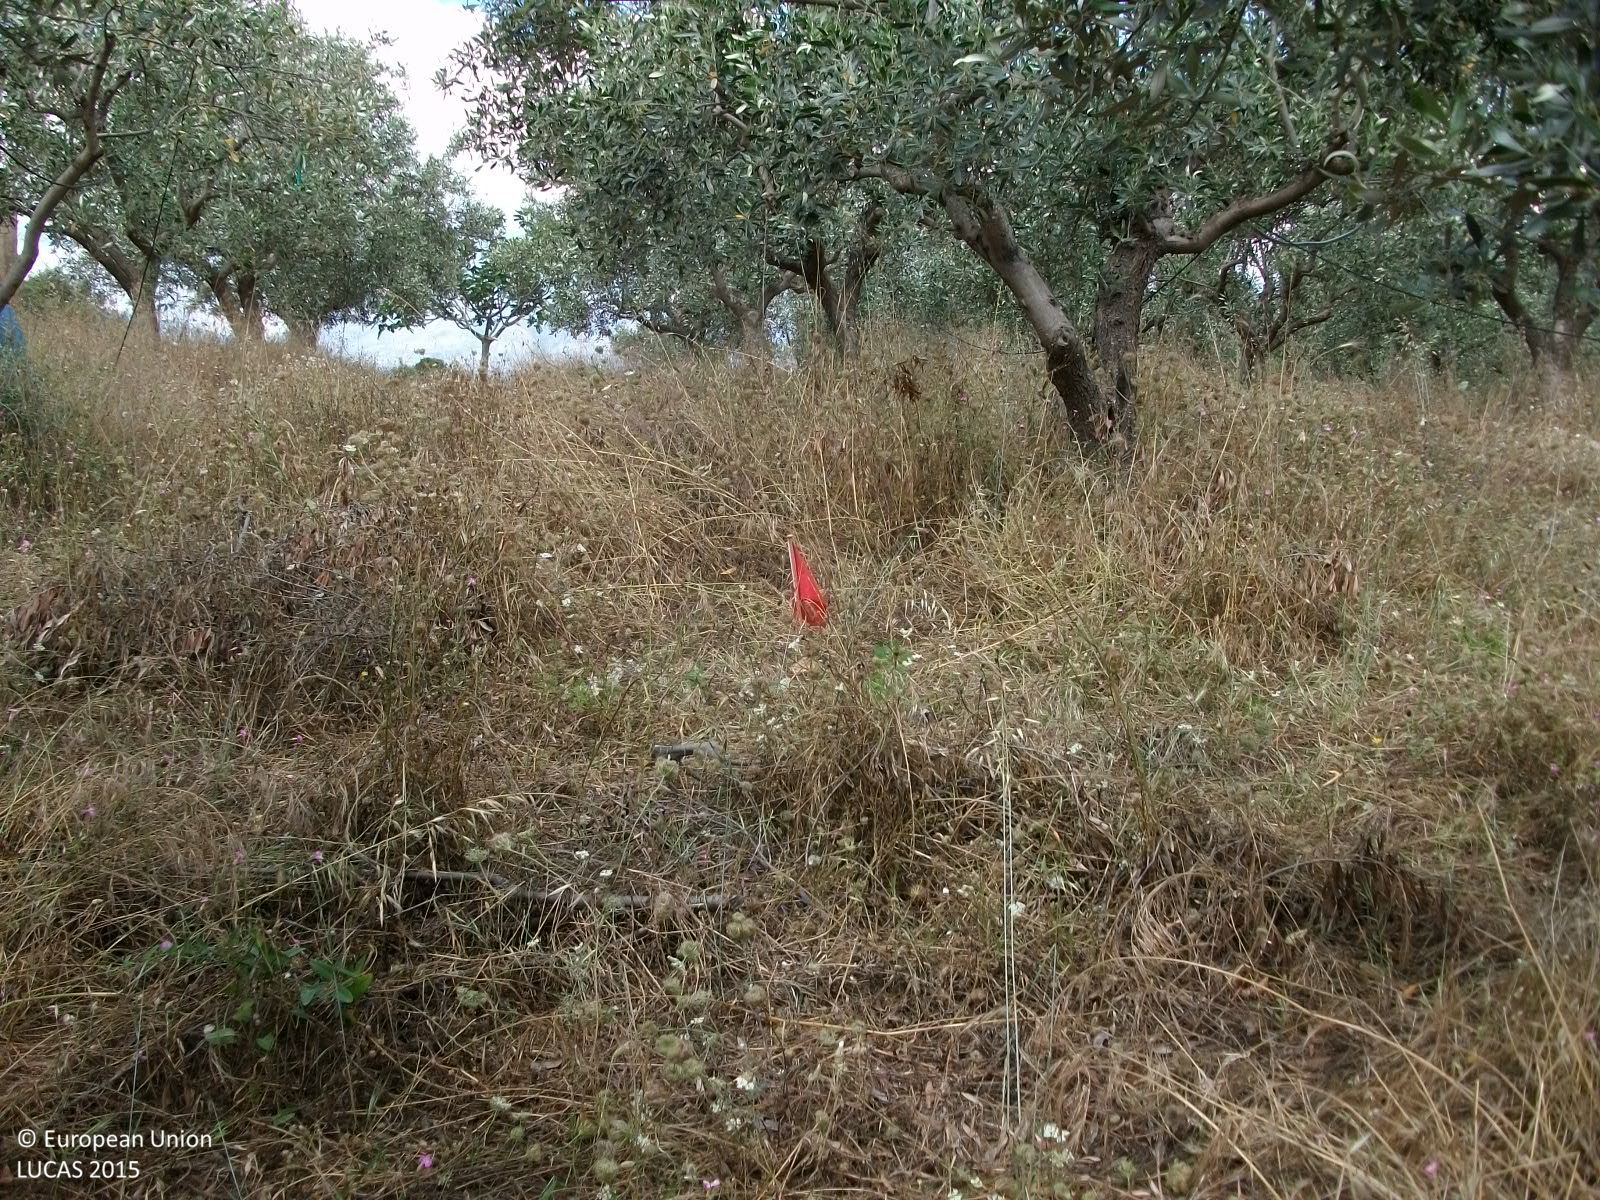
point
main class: Cropland
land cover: Olive groves
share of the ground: 50 - 75 %
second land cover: Spontaneously vegetated surfaces
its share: > 75 %
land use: Agriculture (excluding fallow land and kitchen gardens)
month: June
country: GR
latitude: 37.1647
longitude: 22.4462
